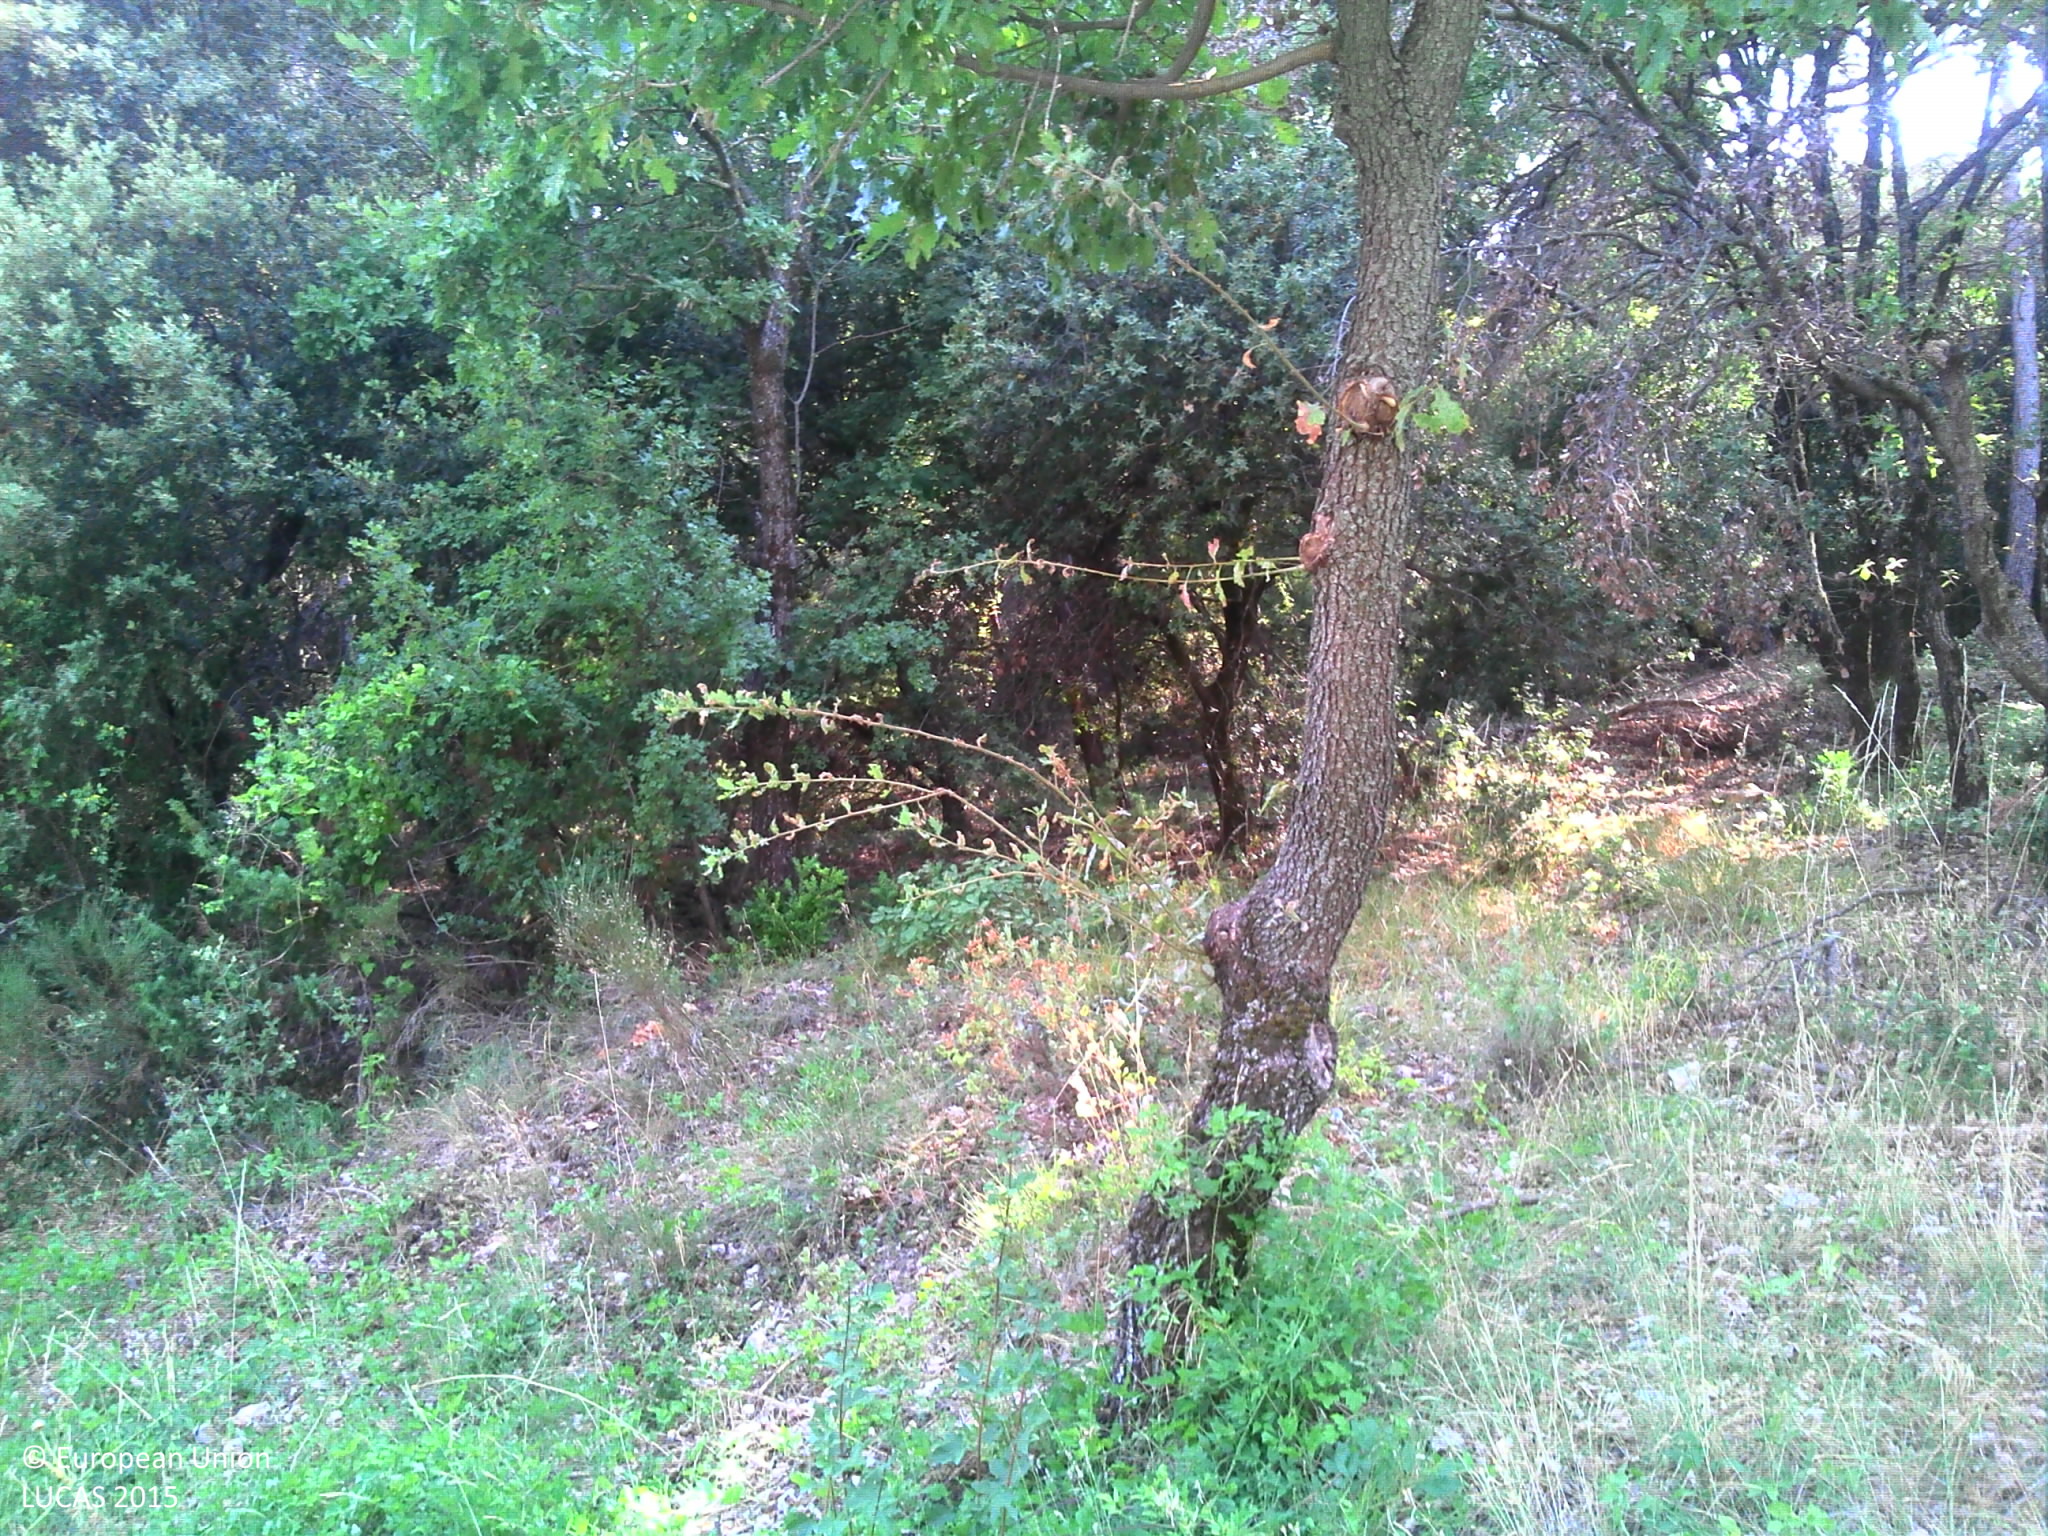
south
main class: Shrubland
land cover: Shrubland with sparse tree cover
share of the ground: > 75 %
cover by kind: shrubs 85 %, unconsolidated bare surface 10 %, broadleaved forest trees 5 %
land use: Community services
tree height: < 5 m
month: August
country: FR
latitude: 43.6415
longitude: 6.5000
